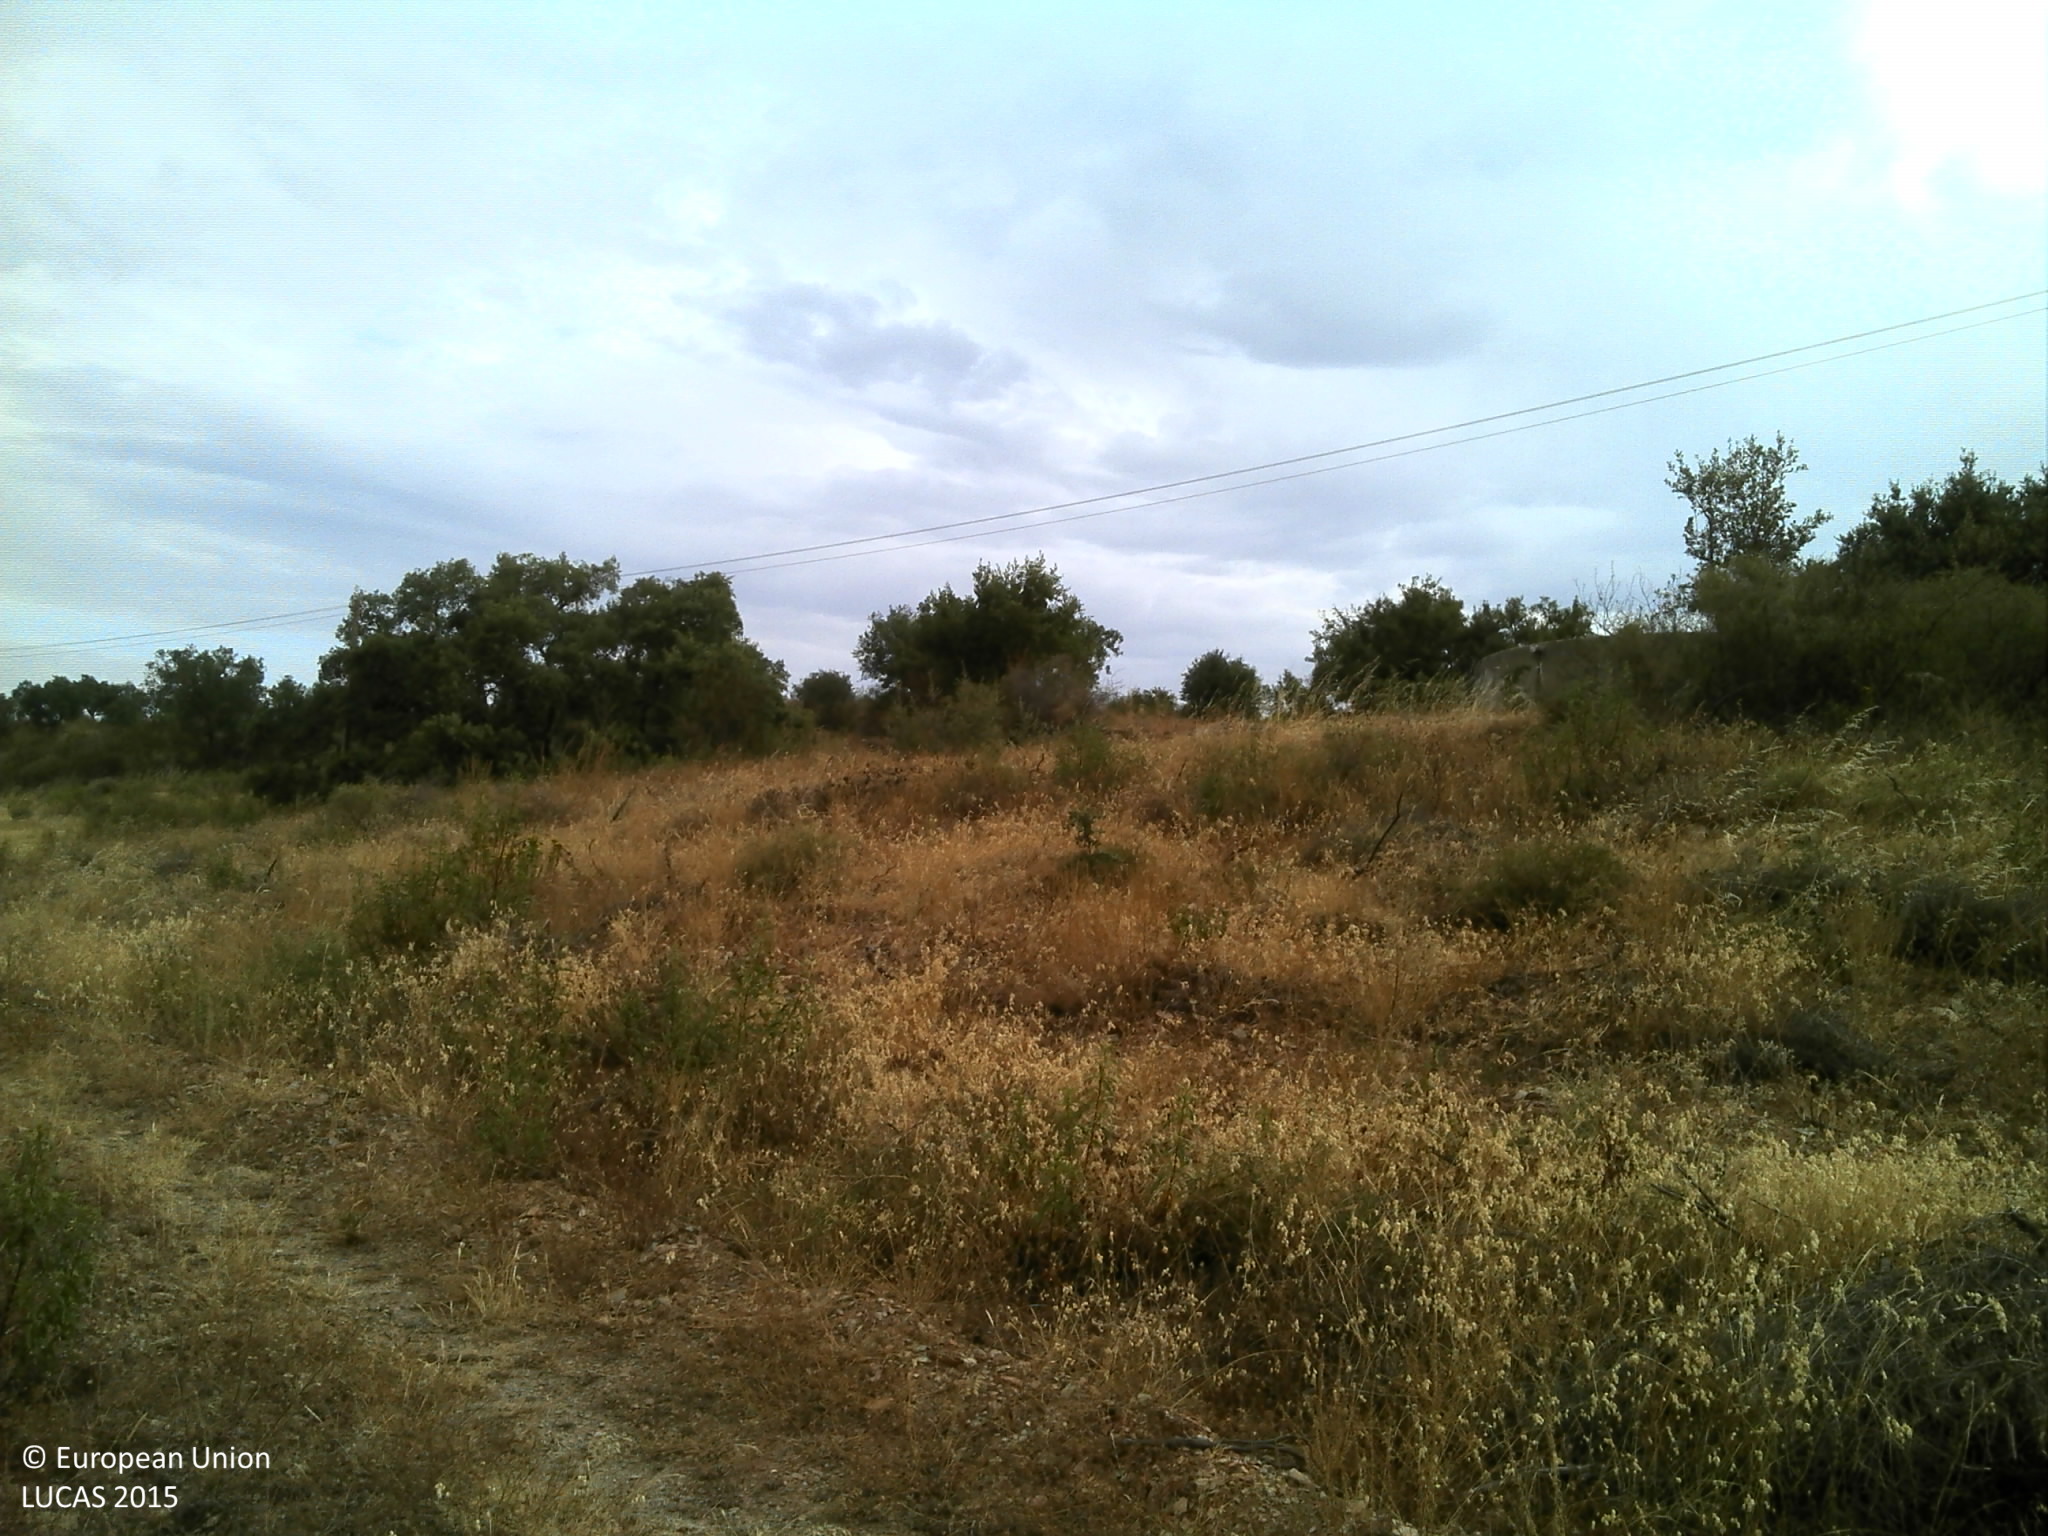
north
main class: Woodland
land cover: Broadleaved woodland
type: broadleaved evergreen forest
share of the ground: 10 - 25 %
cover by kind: herbaceous plants 40 %, broadleaved forest trees 25 %, shrubs 25 %, unconsolidated bare surface 10 %
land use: Forestry
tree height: > 5 m
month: July
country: PT
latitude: 38.7698
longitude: -7.5168
